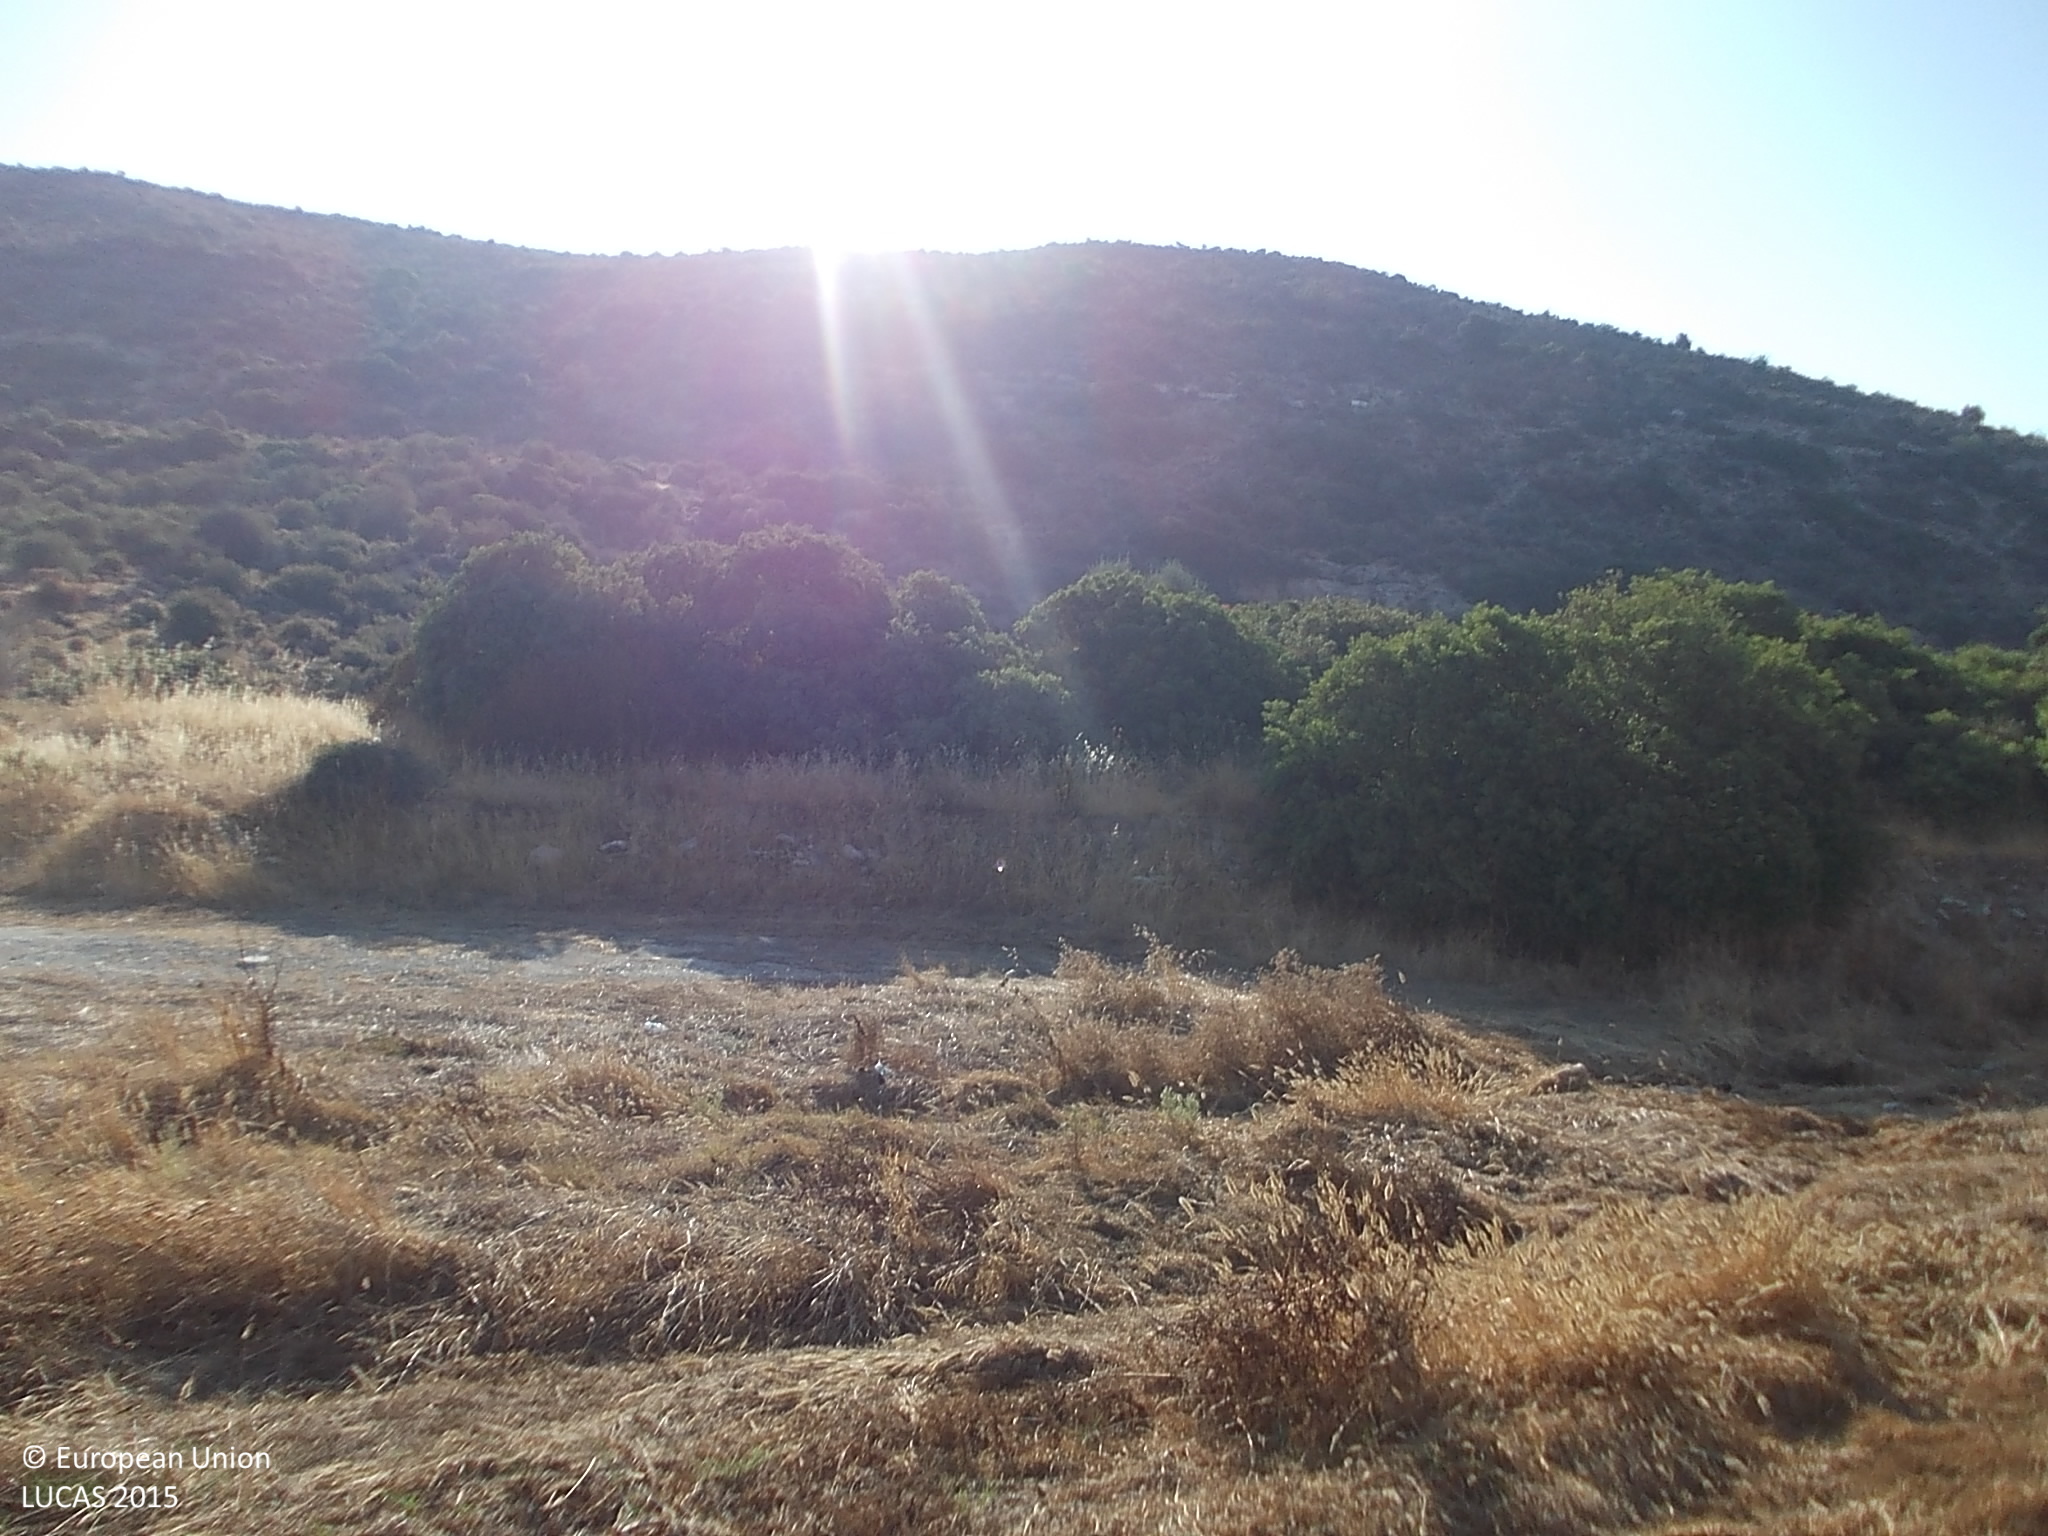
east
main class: Shrubland
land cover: Shrubland without tree cover
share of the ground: > 75 %
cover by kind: shrubs 85 %, herbaceous plants 10 %
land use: Semi-natural and natural areas not in use
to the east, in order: Shrubland without tree cover; Dry stone walls; Shrubland without tree cover; Dry stone walls; Shrubland without tree cover; Pine dominated coniferous woodland; Tracks; Grassland without tree/shrub cover; Tracks; Shrubland without tree cover; Pine dominated coniferous woodland; Inland fresh running water; Shrubland without tree cover
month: August
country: CY
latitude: 34.7250
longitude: 32.9763
